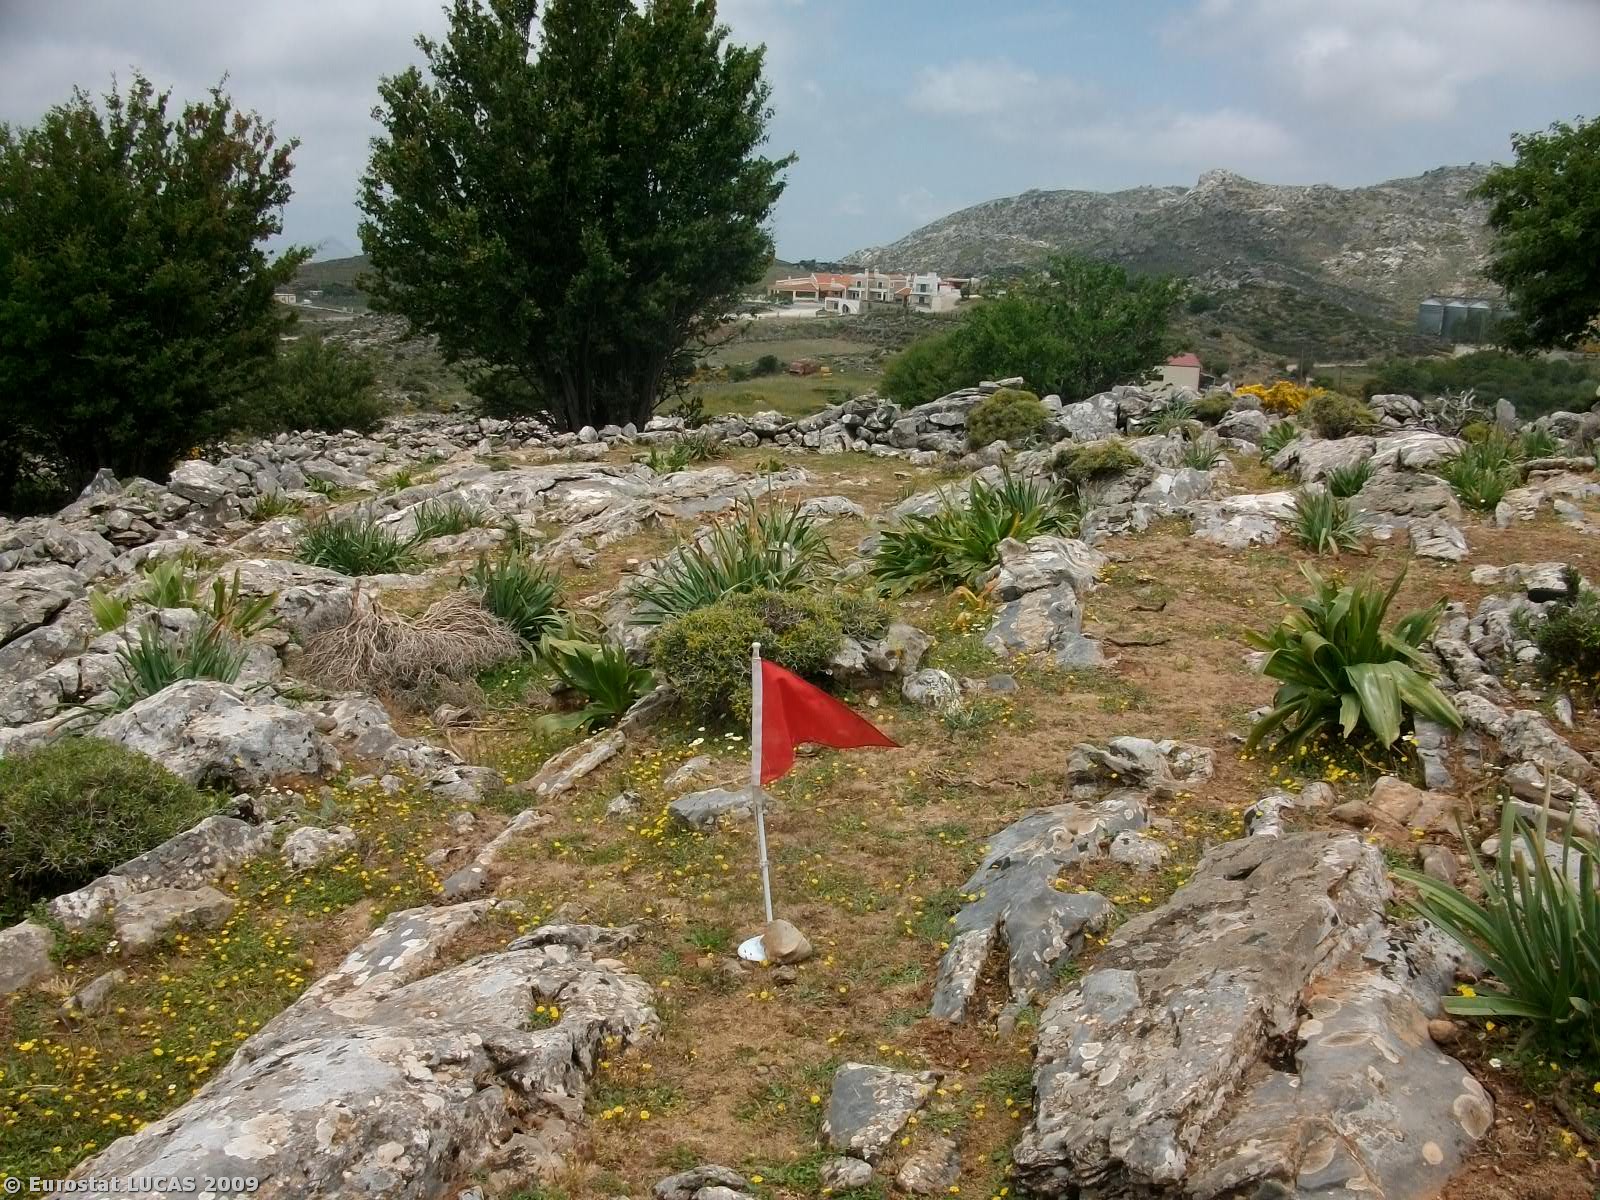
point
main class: Shrubland
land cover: Shrubland with sparse tree cover
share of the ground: > 75 %
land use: Agriculture (excluding fallow land and kitchen gardens)
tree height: < 5 m
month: May
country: GR
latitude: 35.2792
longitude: 24.8867
